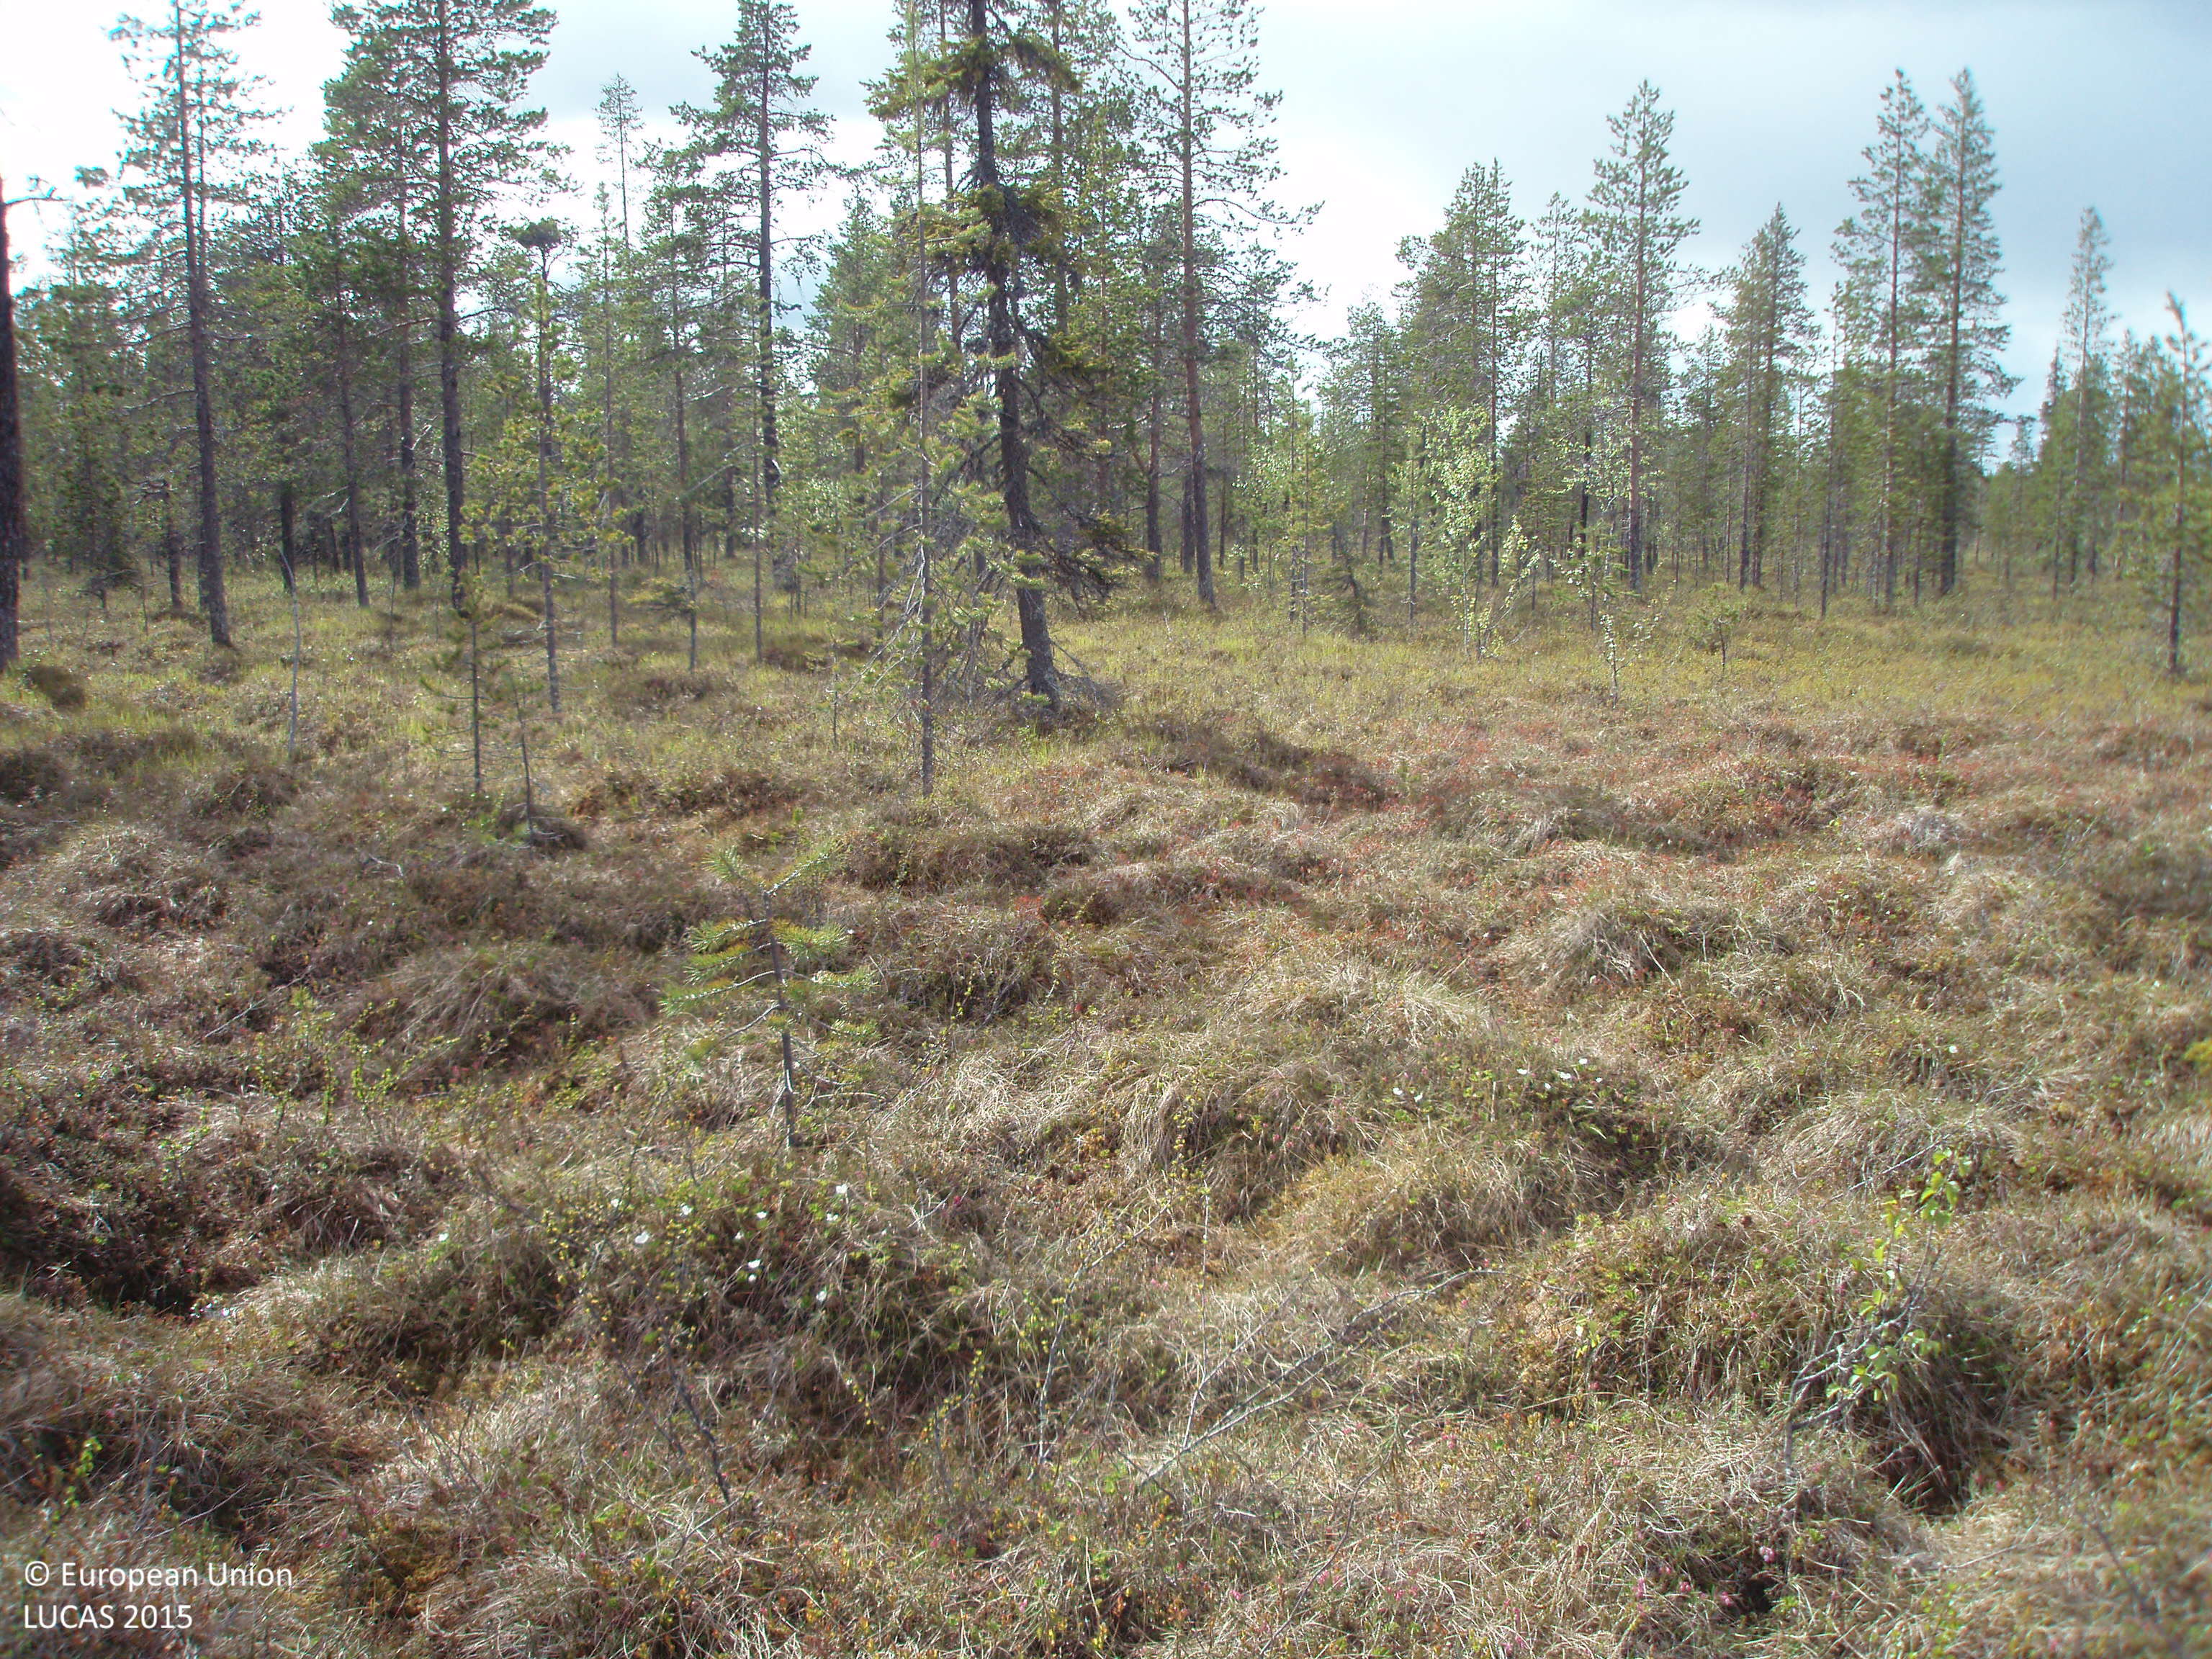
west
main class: Woodland
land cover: Pine dominated coniferous woodland
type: mire and swamp forests
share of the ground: 10 - 25 %
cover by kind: shrubs 50 %, lichens and mosses 20 %, coniferous forest trees 15 %, herbaceous plants 10 %, broadleaved forest trees 5 %
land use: Semi-natural and natural areas not in use
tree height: > 5 m
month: June
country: FI
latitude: 67.9756
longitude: 26.8222
